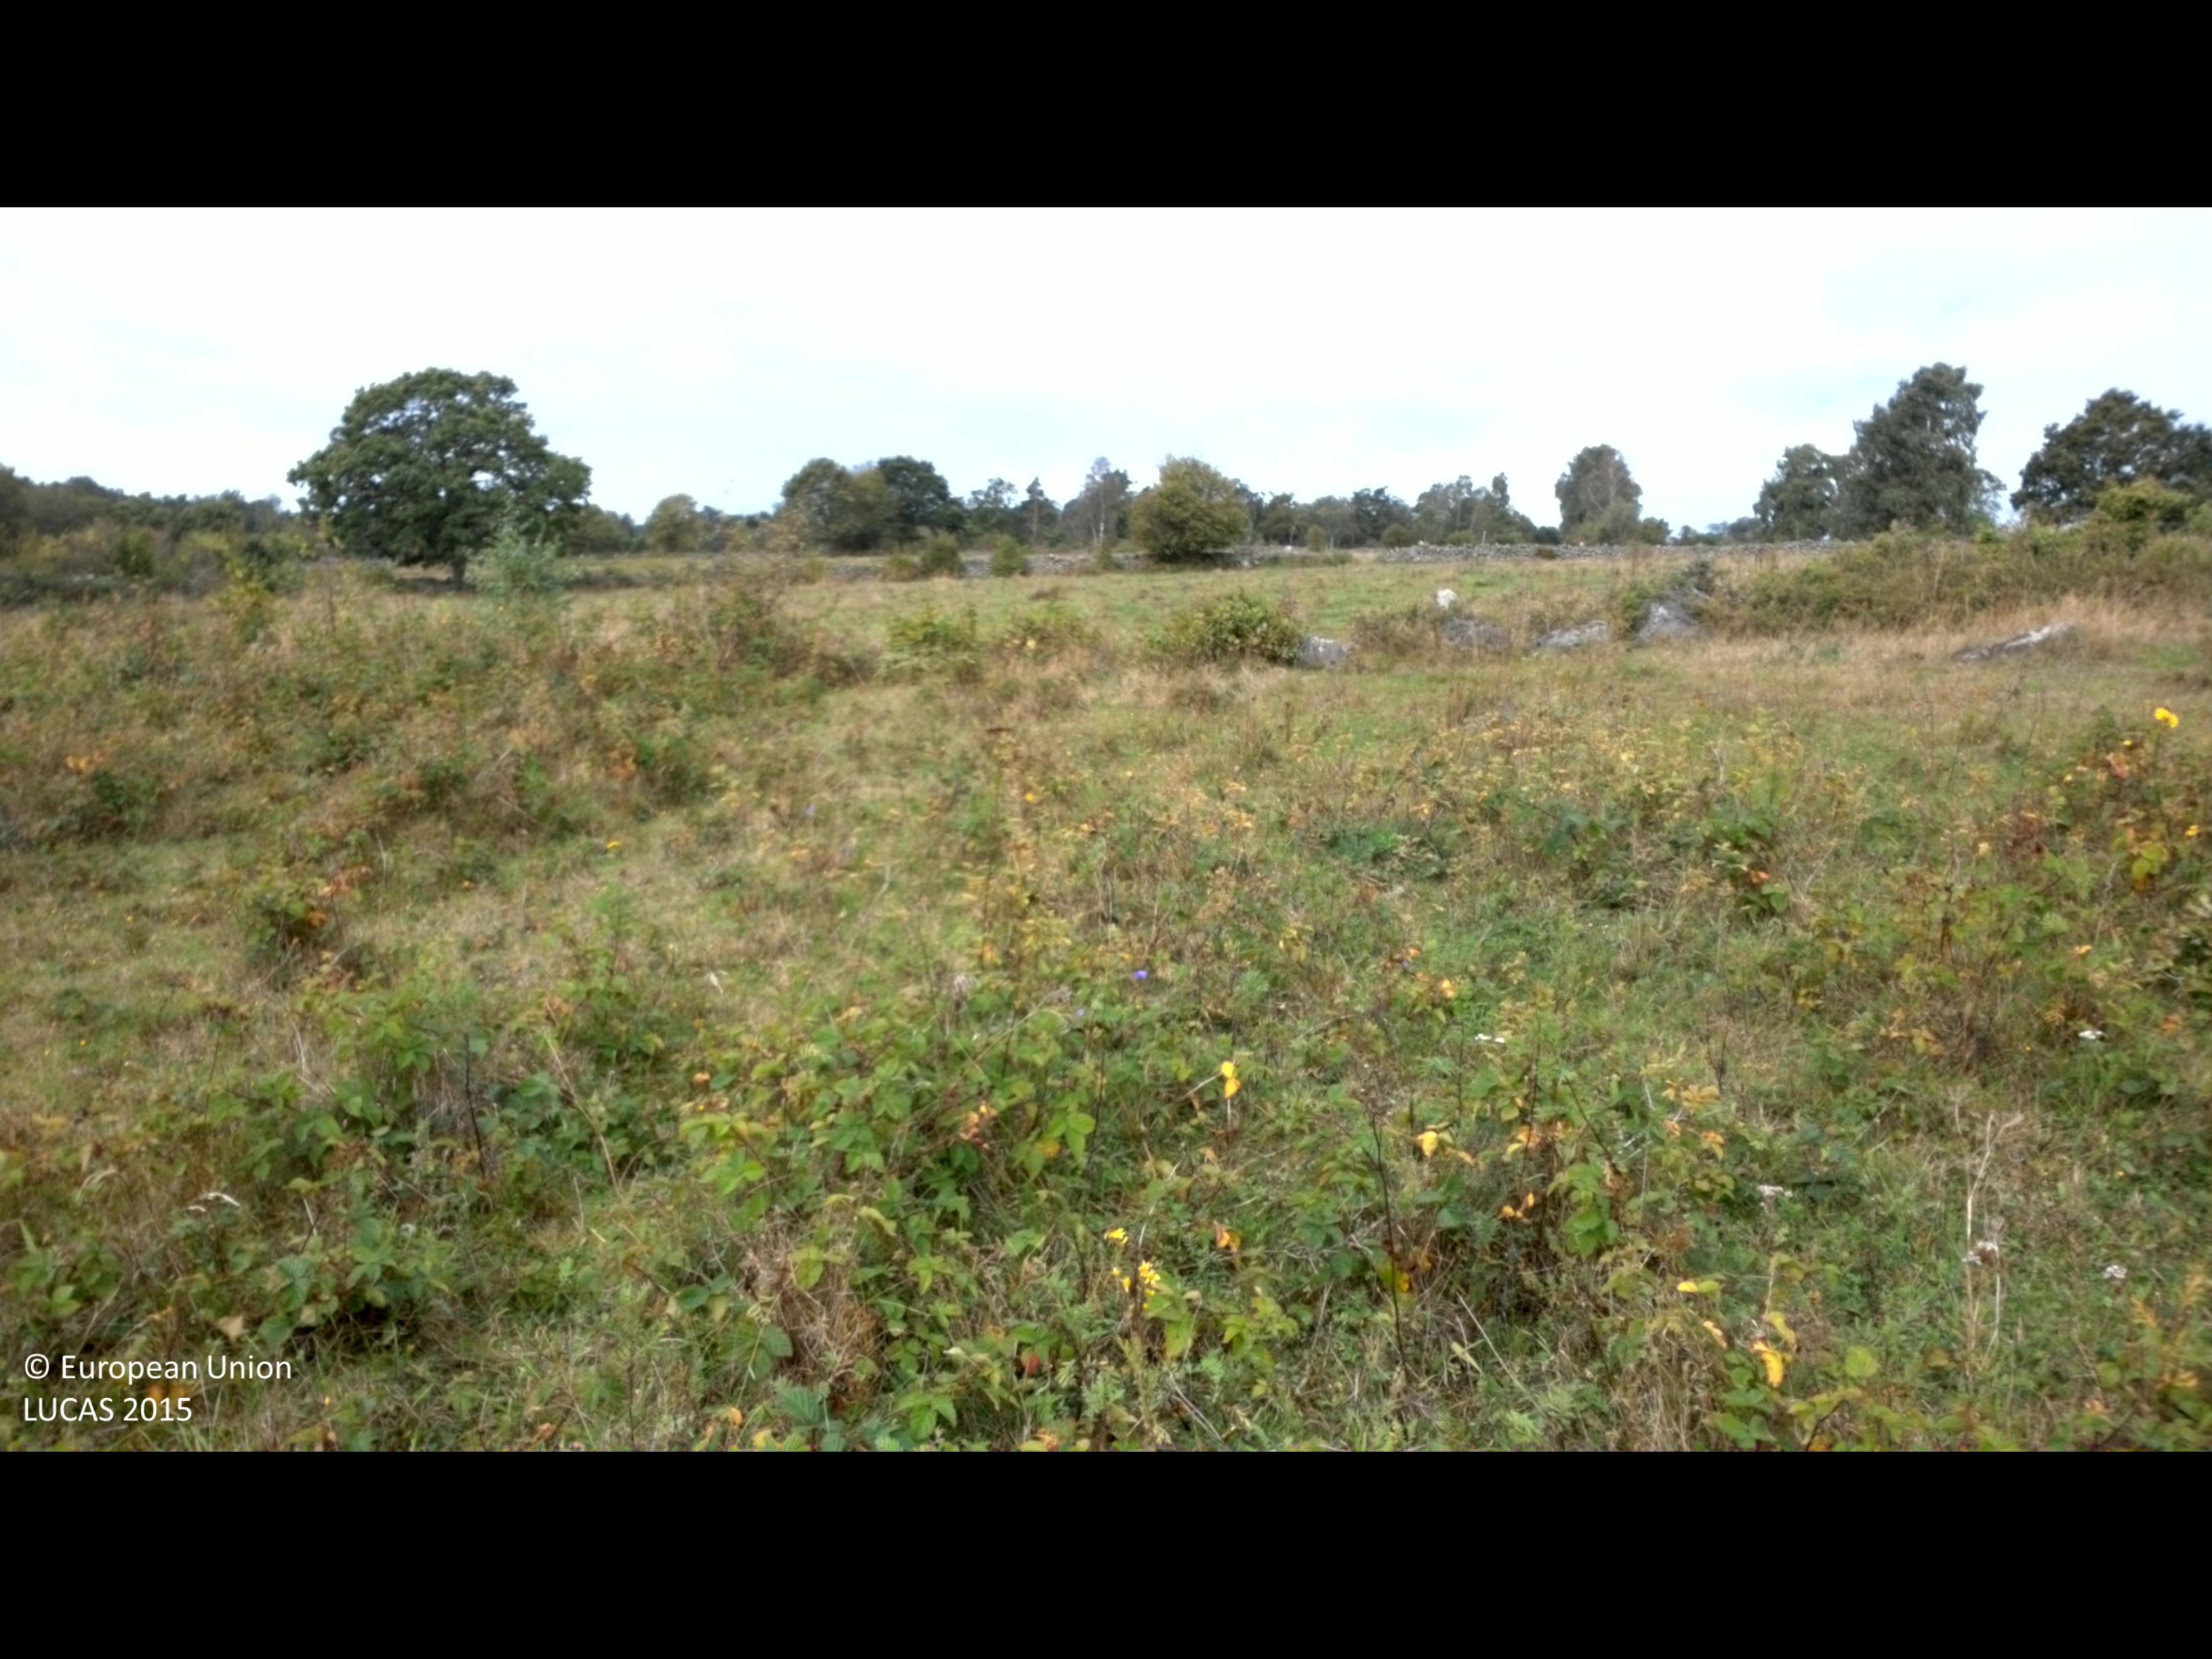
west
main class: Grassland
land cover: Grassland without tree/shrub cover
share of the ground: > 75 %
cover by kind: herbaceous plants 95 %, shrubs 5 %
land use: Agriculture (excluding fallow land and kitchen gardens)
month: September
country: SE
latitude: 56.0702
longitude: 14.5765
